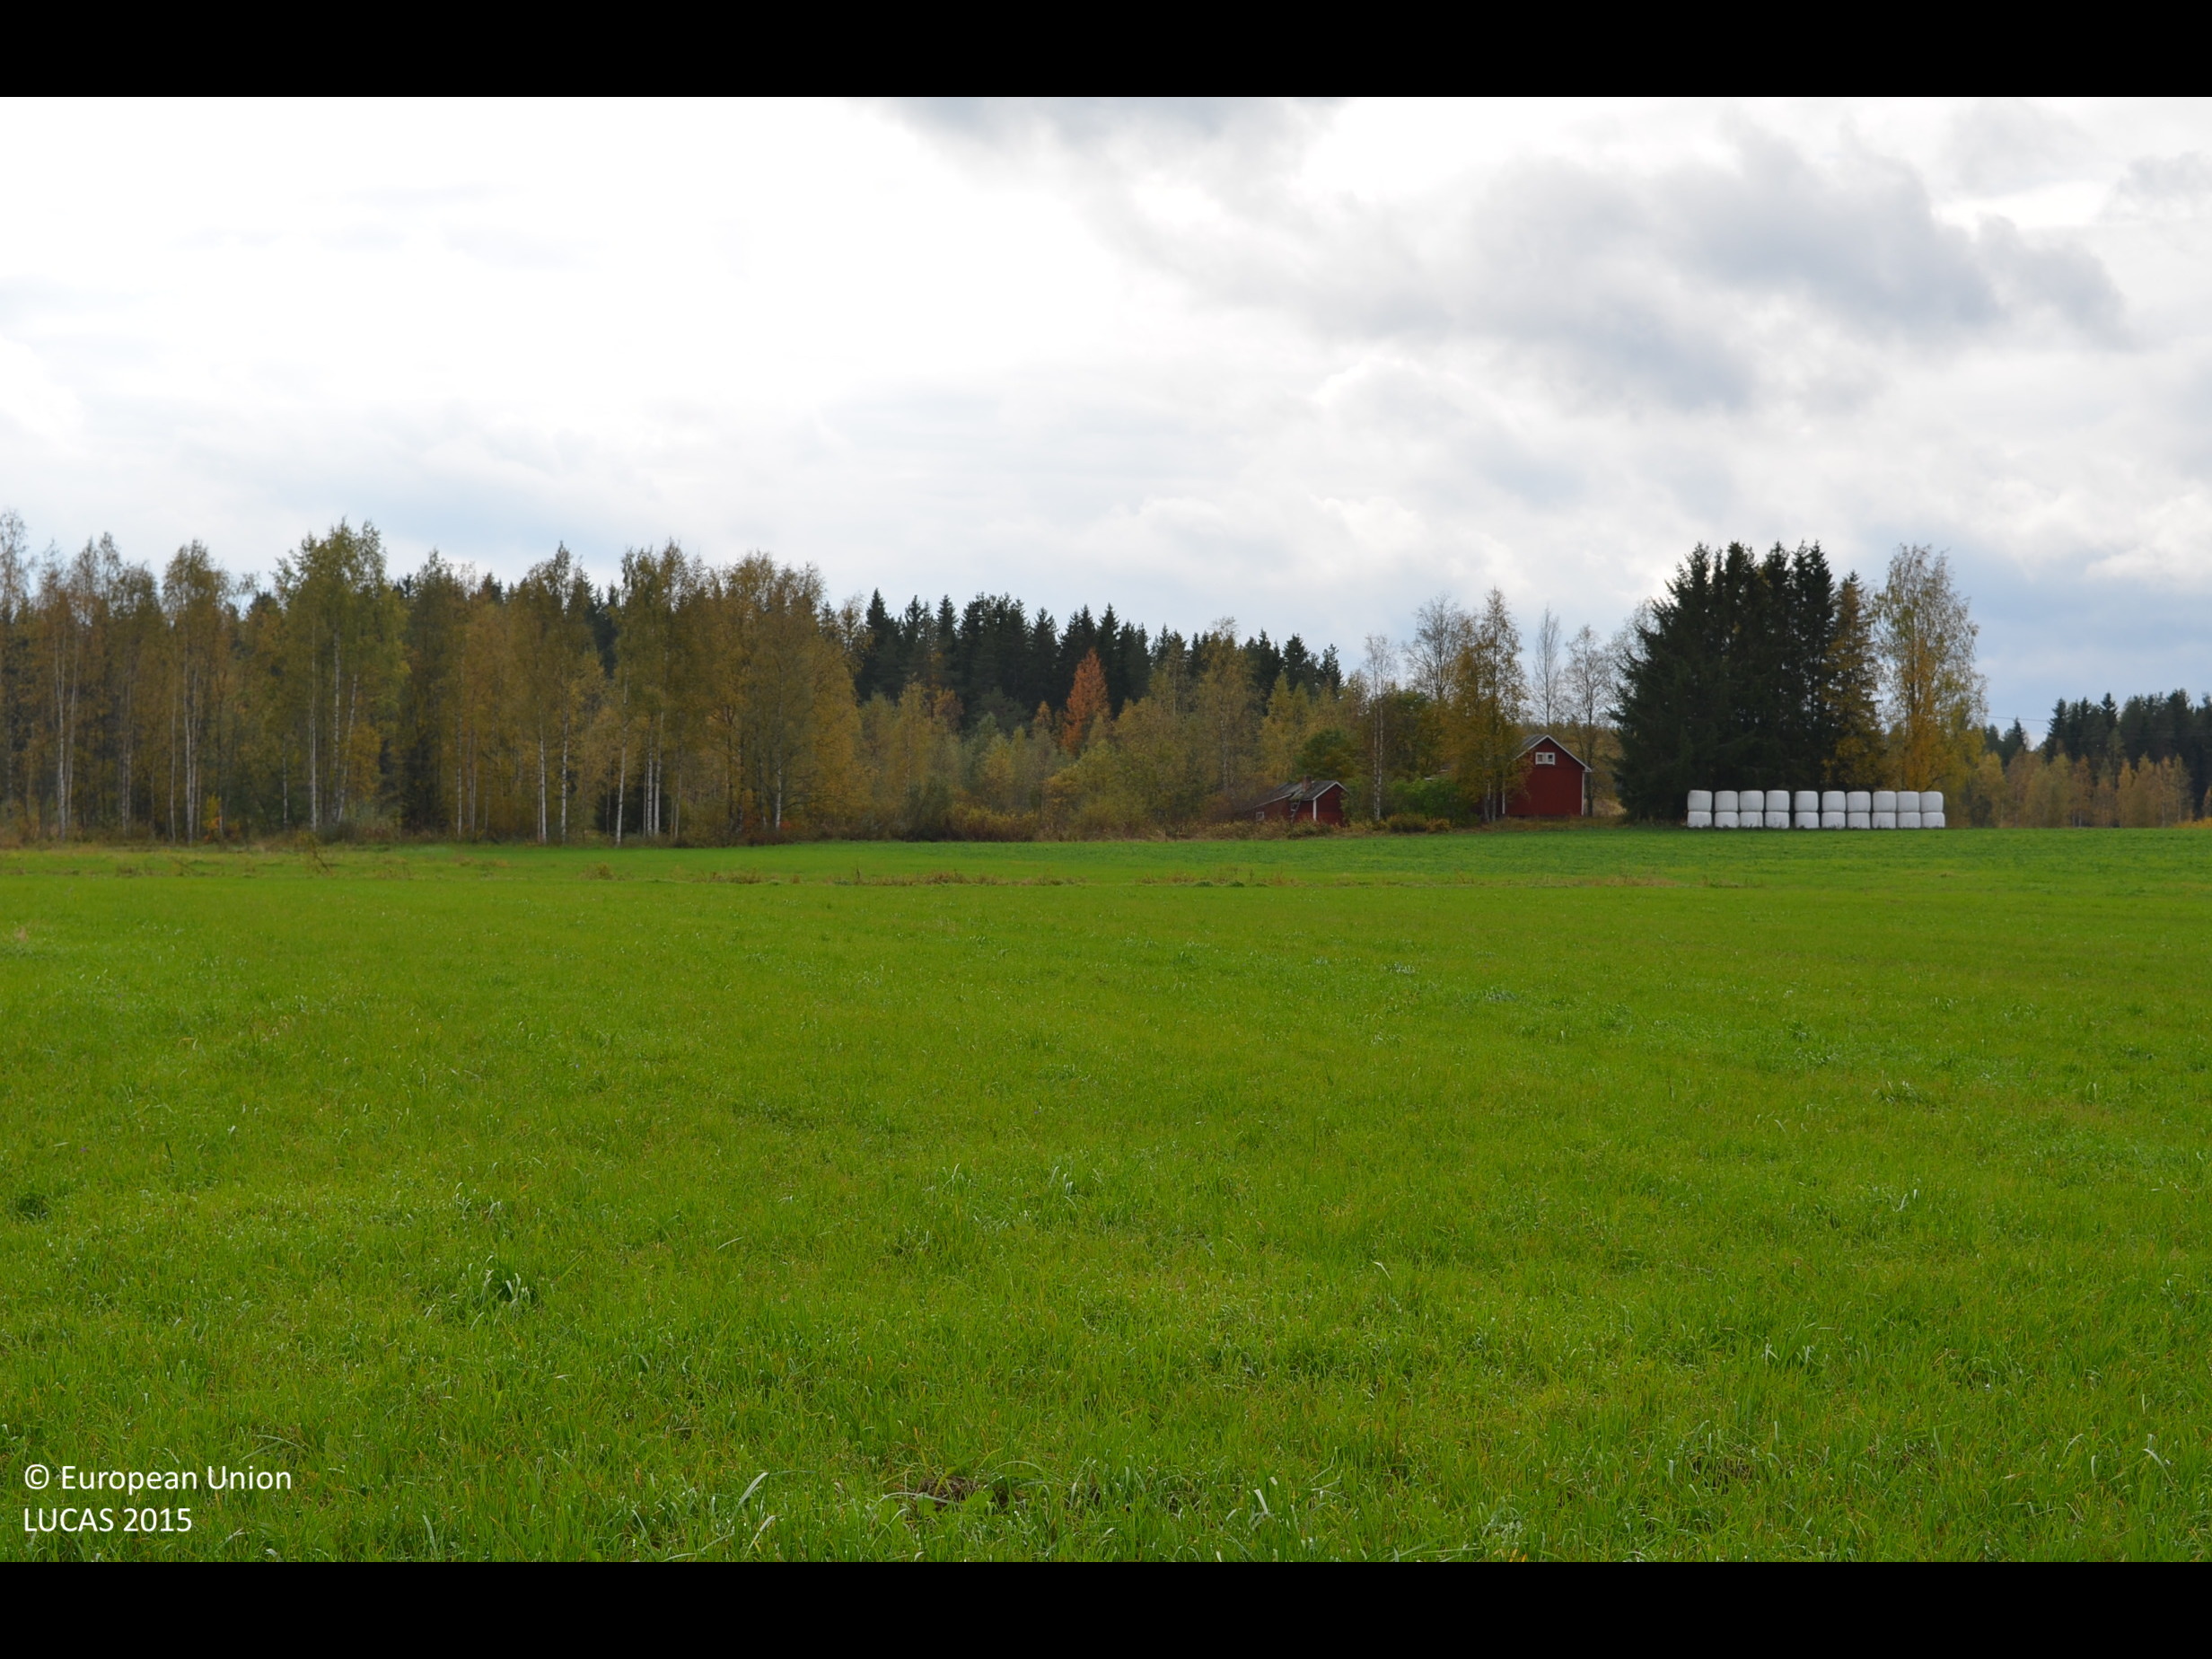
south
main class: Cropland
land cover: Temporary grasslands
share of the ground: > 75 %
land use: Agriculture (excluding fallow land and kitchen gardens)
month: September
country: FI
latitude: 62.4449
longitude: 23.6575
